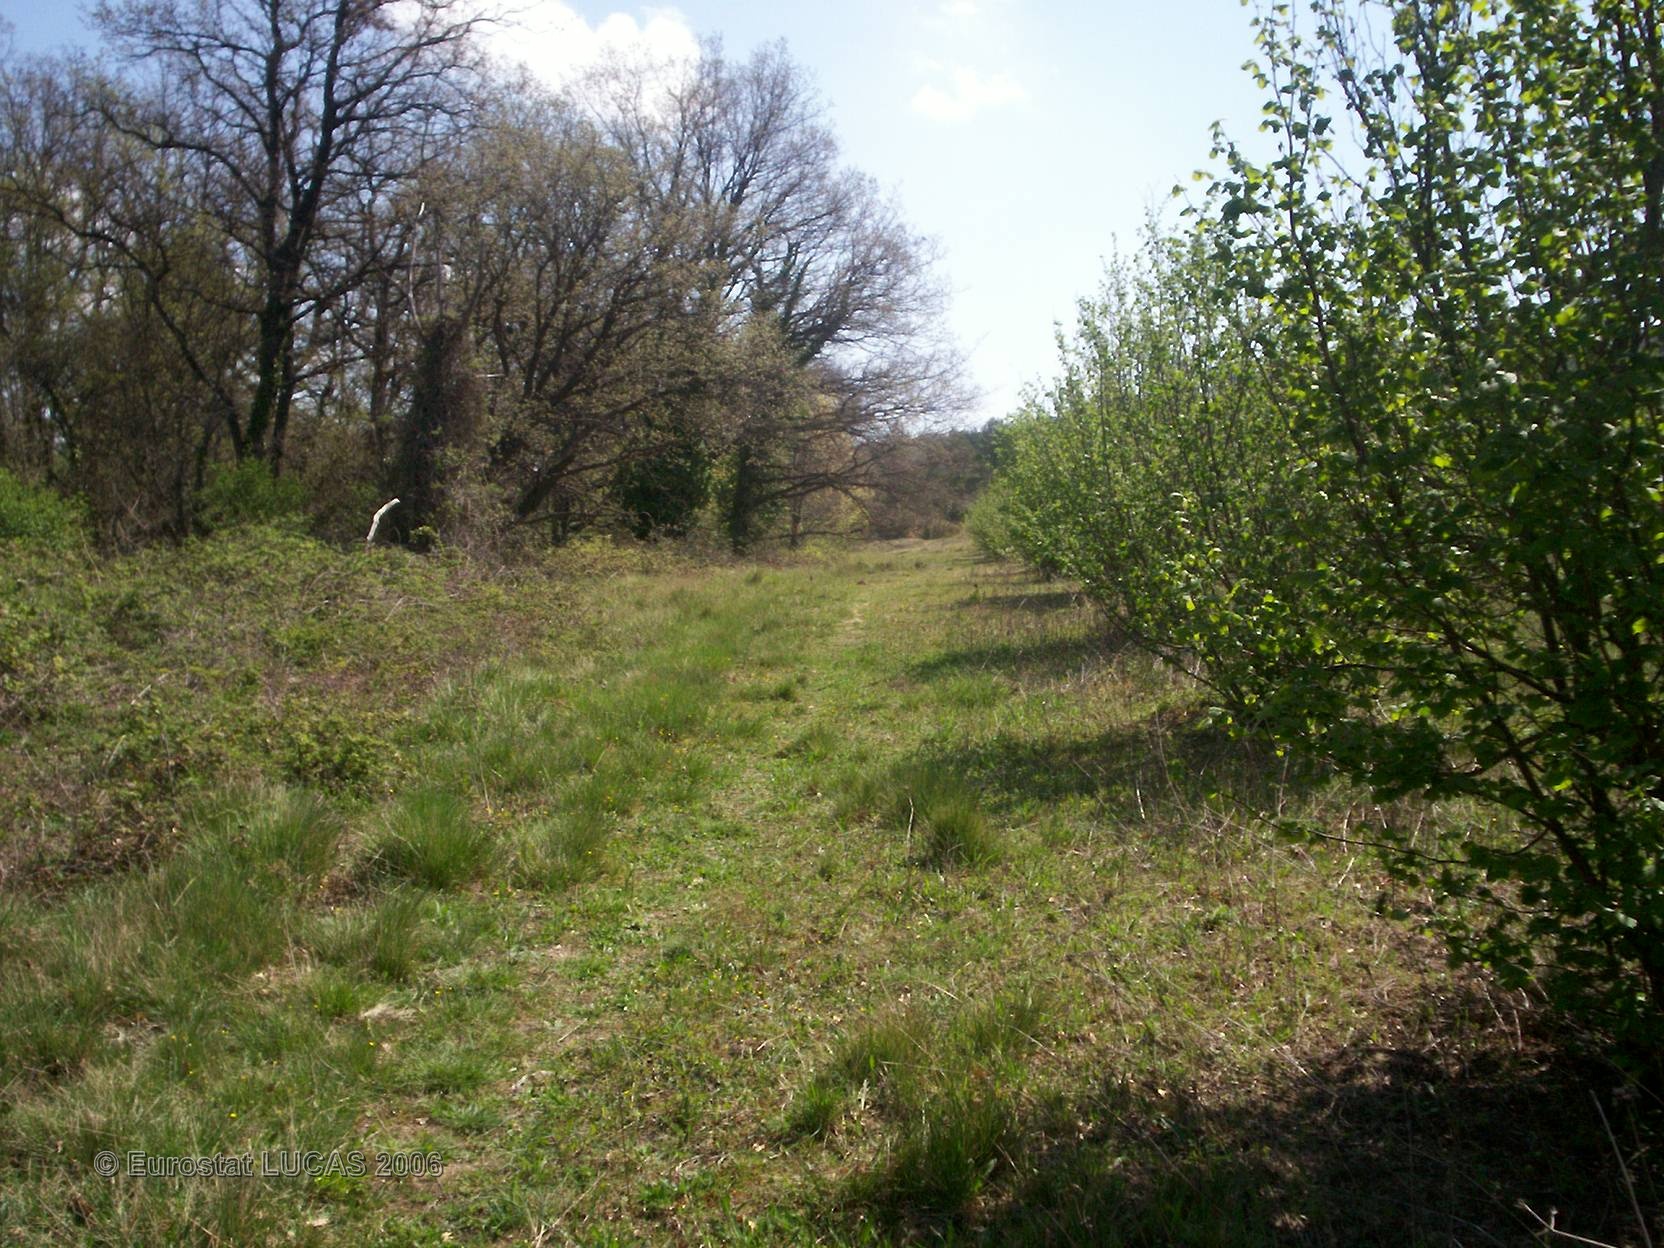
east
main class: Cropland
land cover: Nuts trees
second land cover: Grassland with sparse tree/shrub cover
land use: Agriculture (excluding fallow land and kitchen gardens)
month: April
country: FR
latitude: 43.5163
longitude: 5.5932
